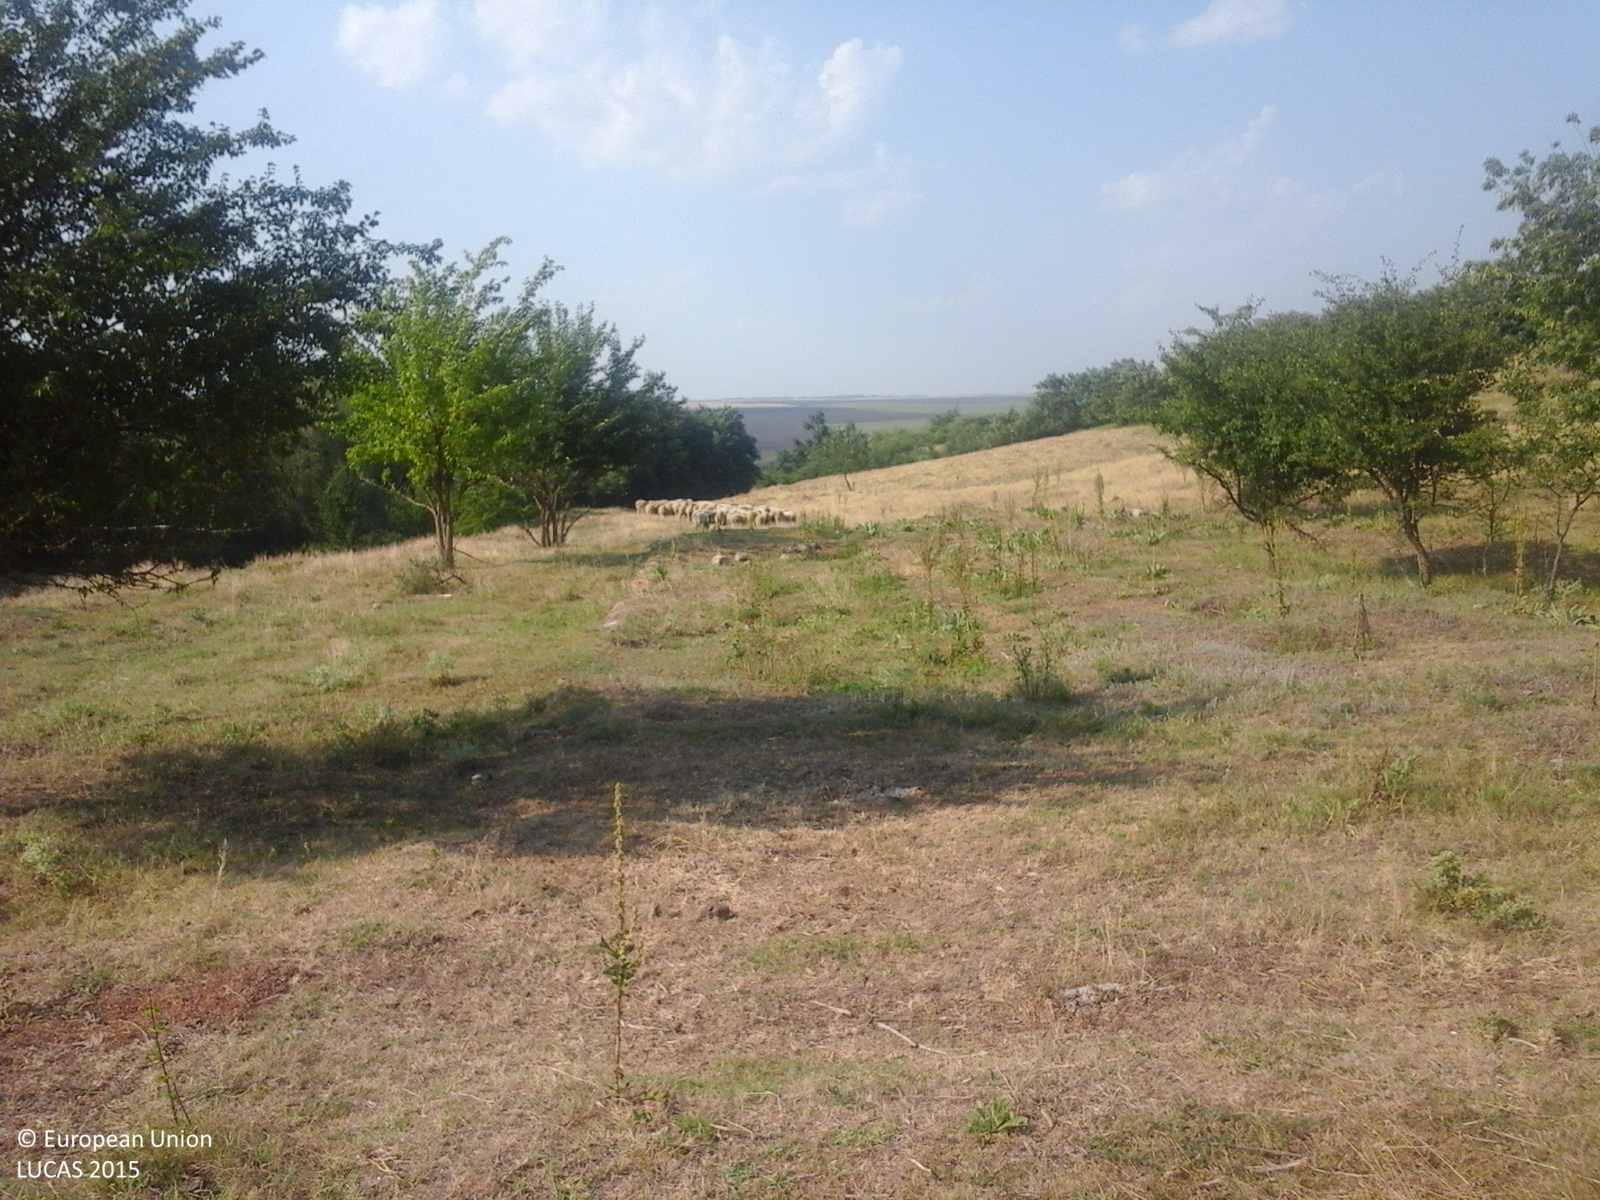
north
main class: Grassland
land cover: Grassland with sparse tree/shrub cover
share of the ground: > 75 %
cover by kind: herbaceous plants 95 %, broadleaved forest trees 5 %
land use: Agriculture (excluding fallow land and kitchen gardens)
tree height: > 5 m
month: July
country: RO
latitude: 46.1002
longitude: 27.7733
